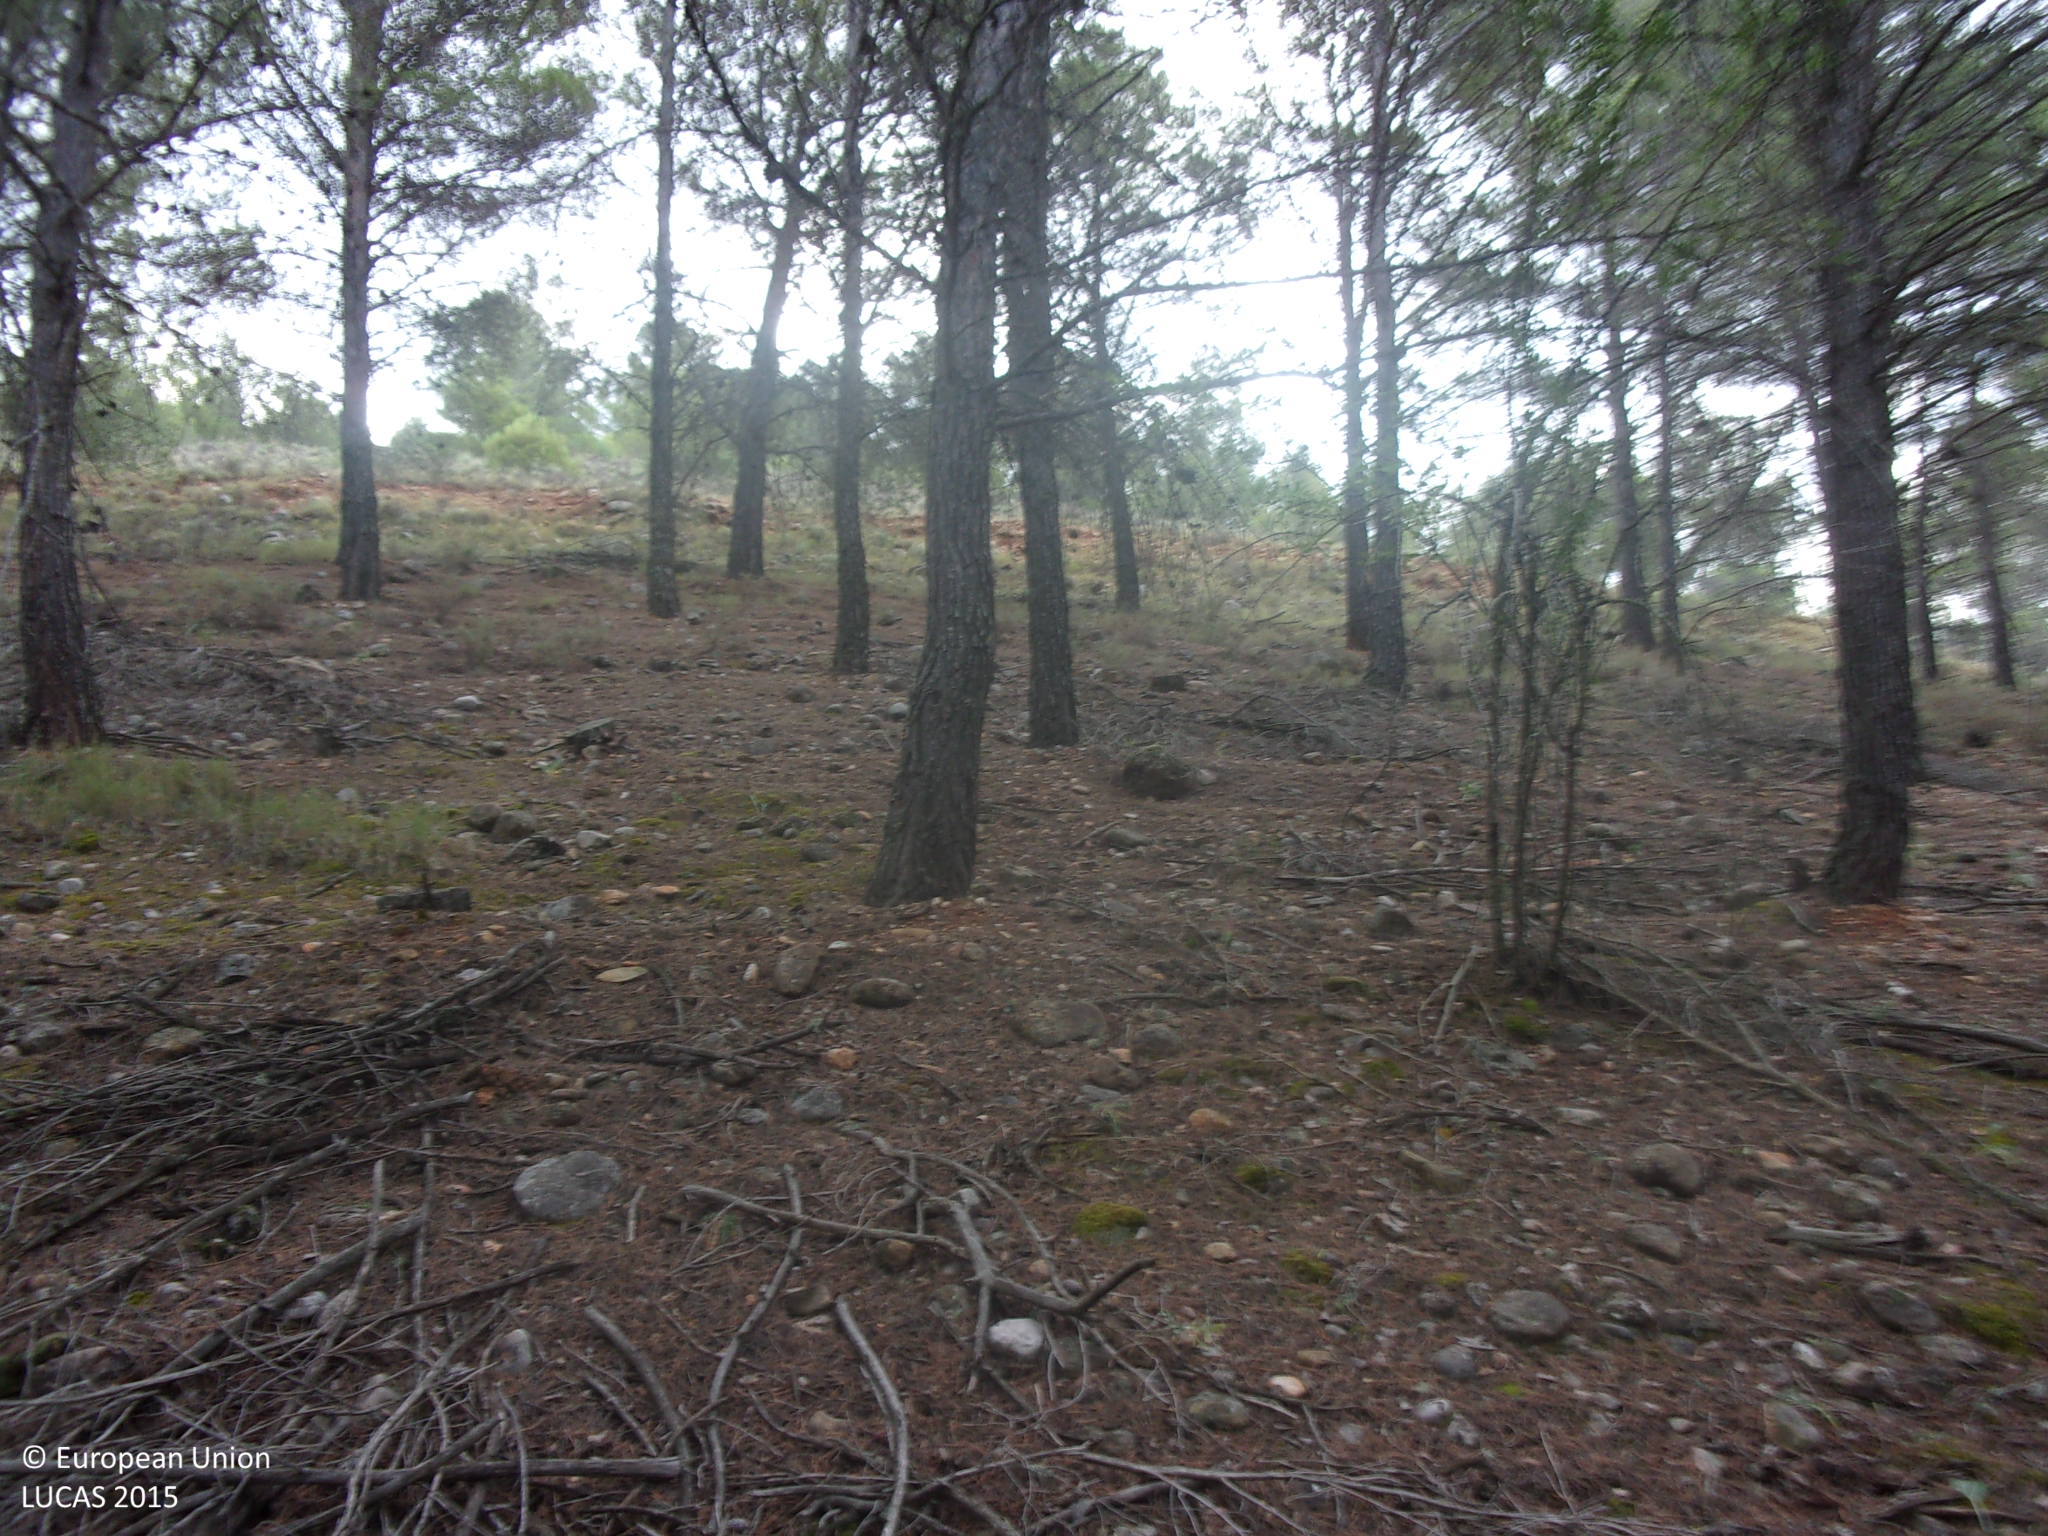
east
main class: Woodland
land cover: Pine dominated coniferous woodland
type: coniferous forest of the mediterranean region
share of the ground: > 75 %
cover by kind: coniferous forest trees 85 %, herbaceous plants 15 %
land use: Forestry
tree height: < 5 m
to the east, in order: Pine dominated coniferous woodland; Shrubland with sparse tree cover; Pine dominated coniferous woodland; Shrubland with sparse tree cover; Pine dominated coniferous woodland
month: July
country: ES
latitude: 41.1907
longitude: -1.8411
